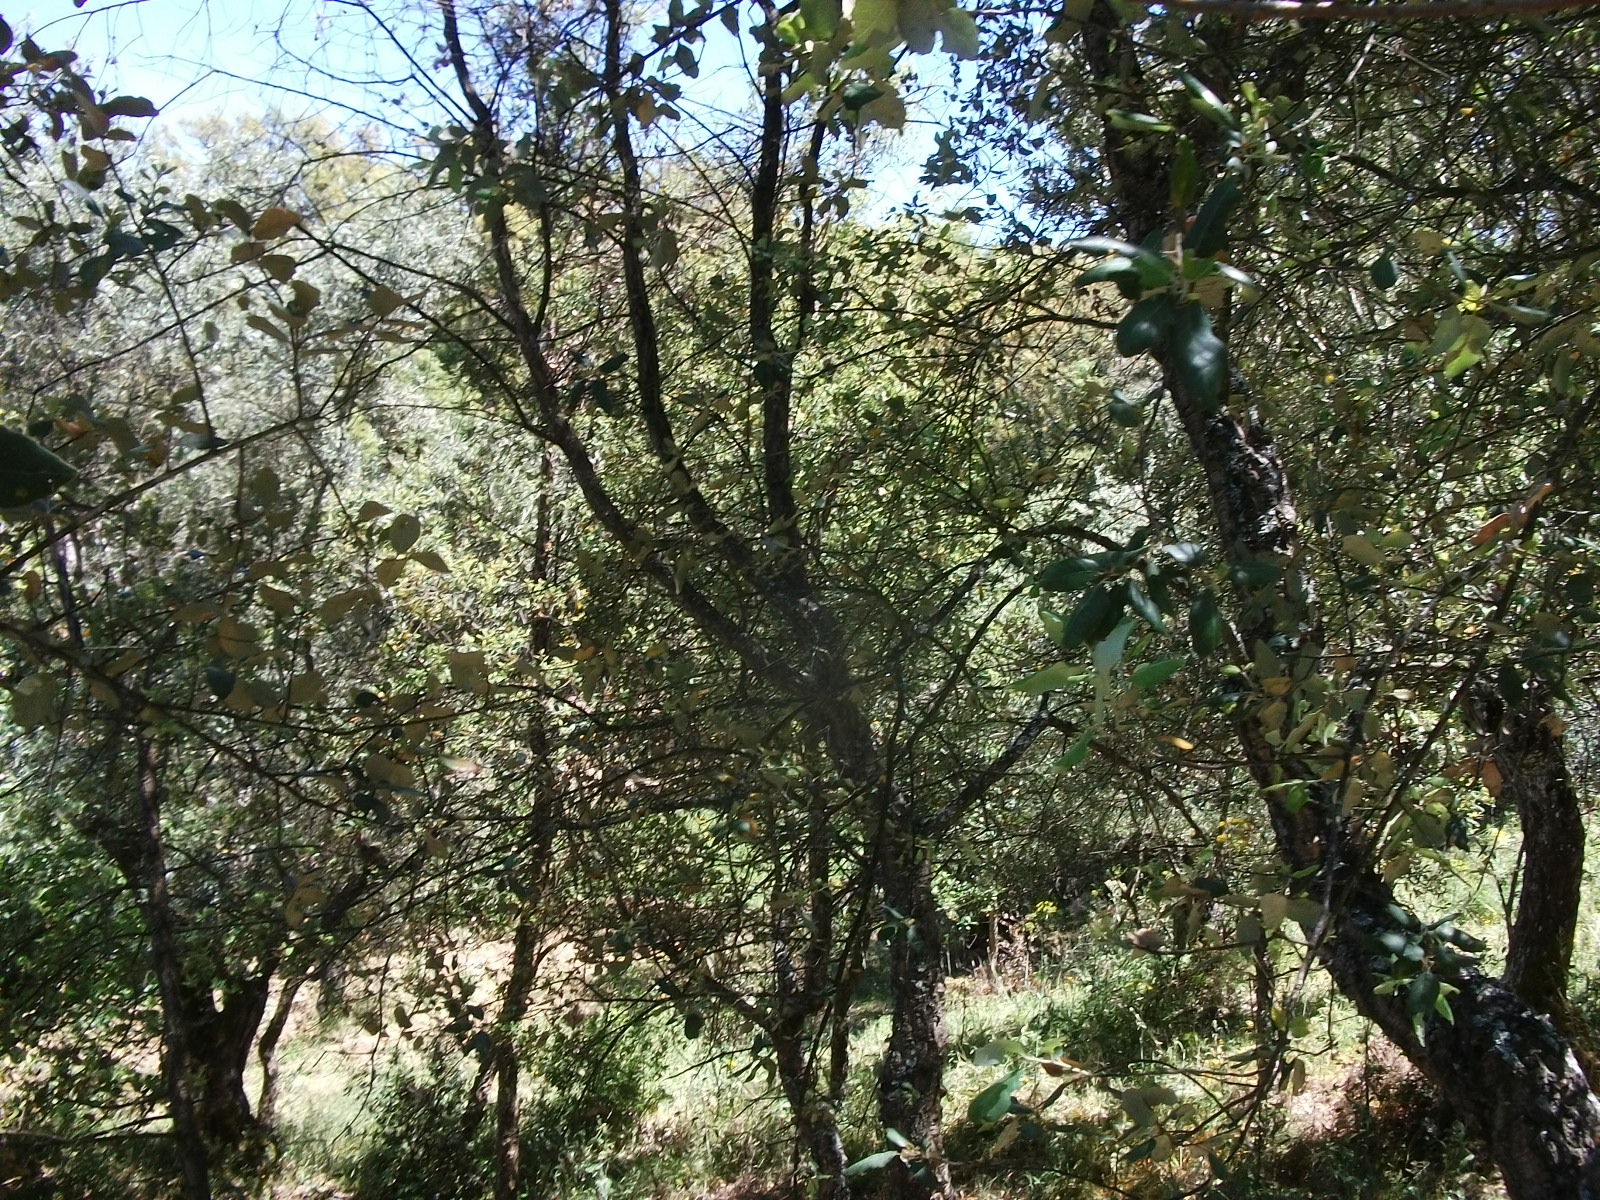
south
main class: Cropland
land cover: Olive groves
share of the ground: 10 - 25 %
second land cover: Spontaneously vegetated surfaces
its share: > 75 %
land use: Agriculture (excluding fallow land and kitchen gardens)
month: May
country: ES
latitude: 37.9346
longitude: -6.6228
